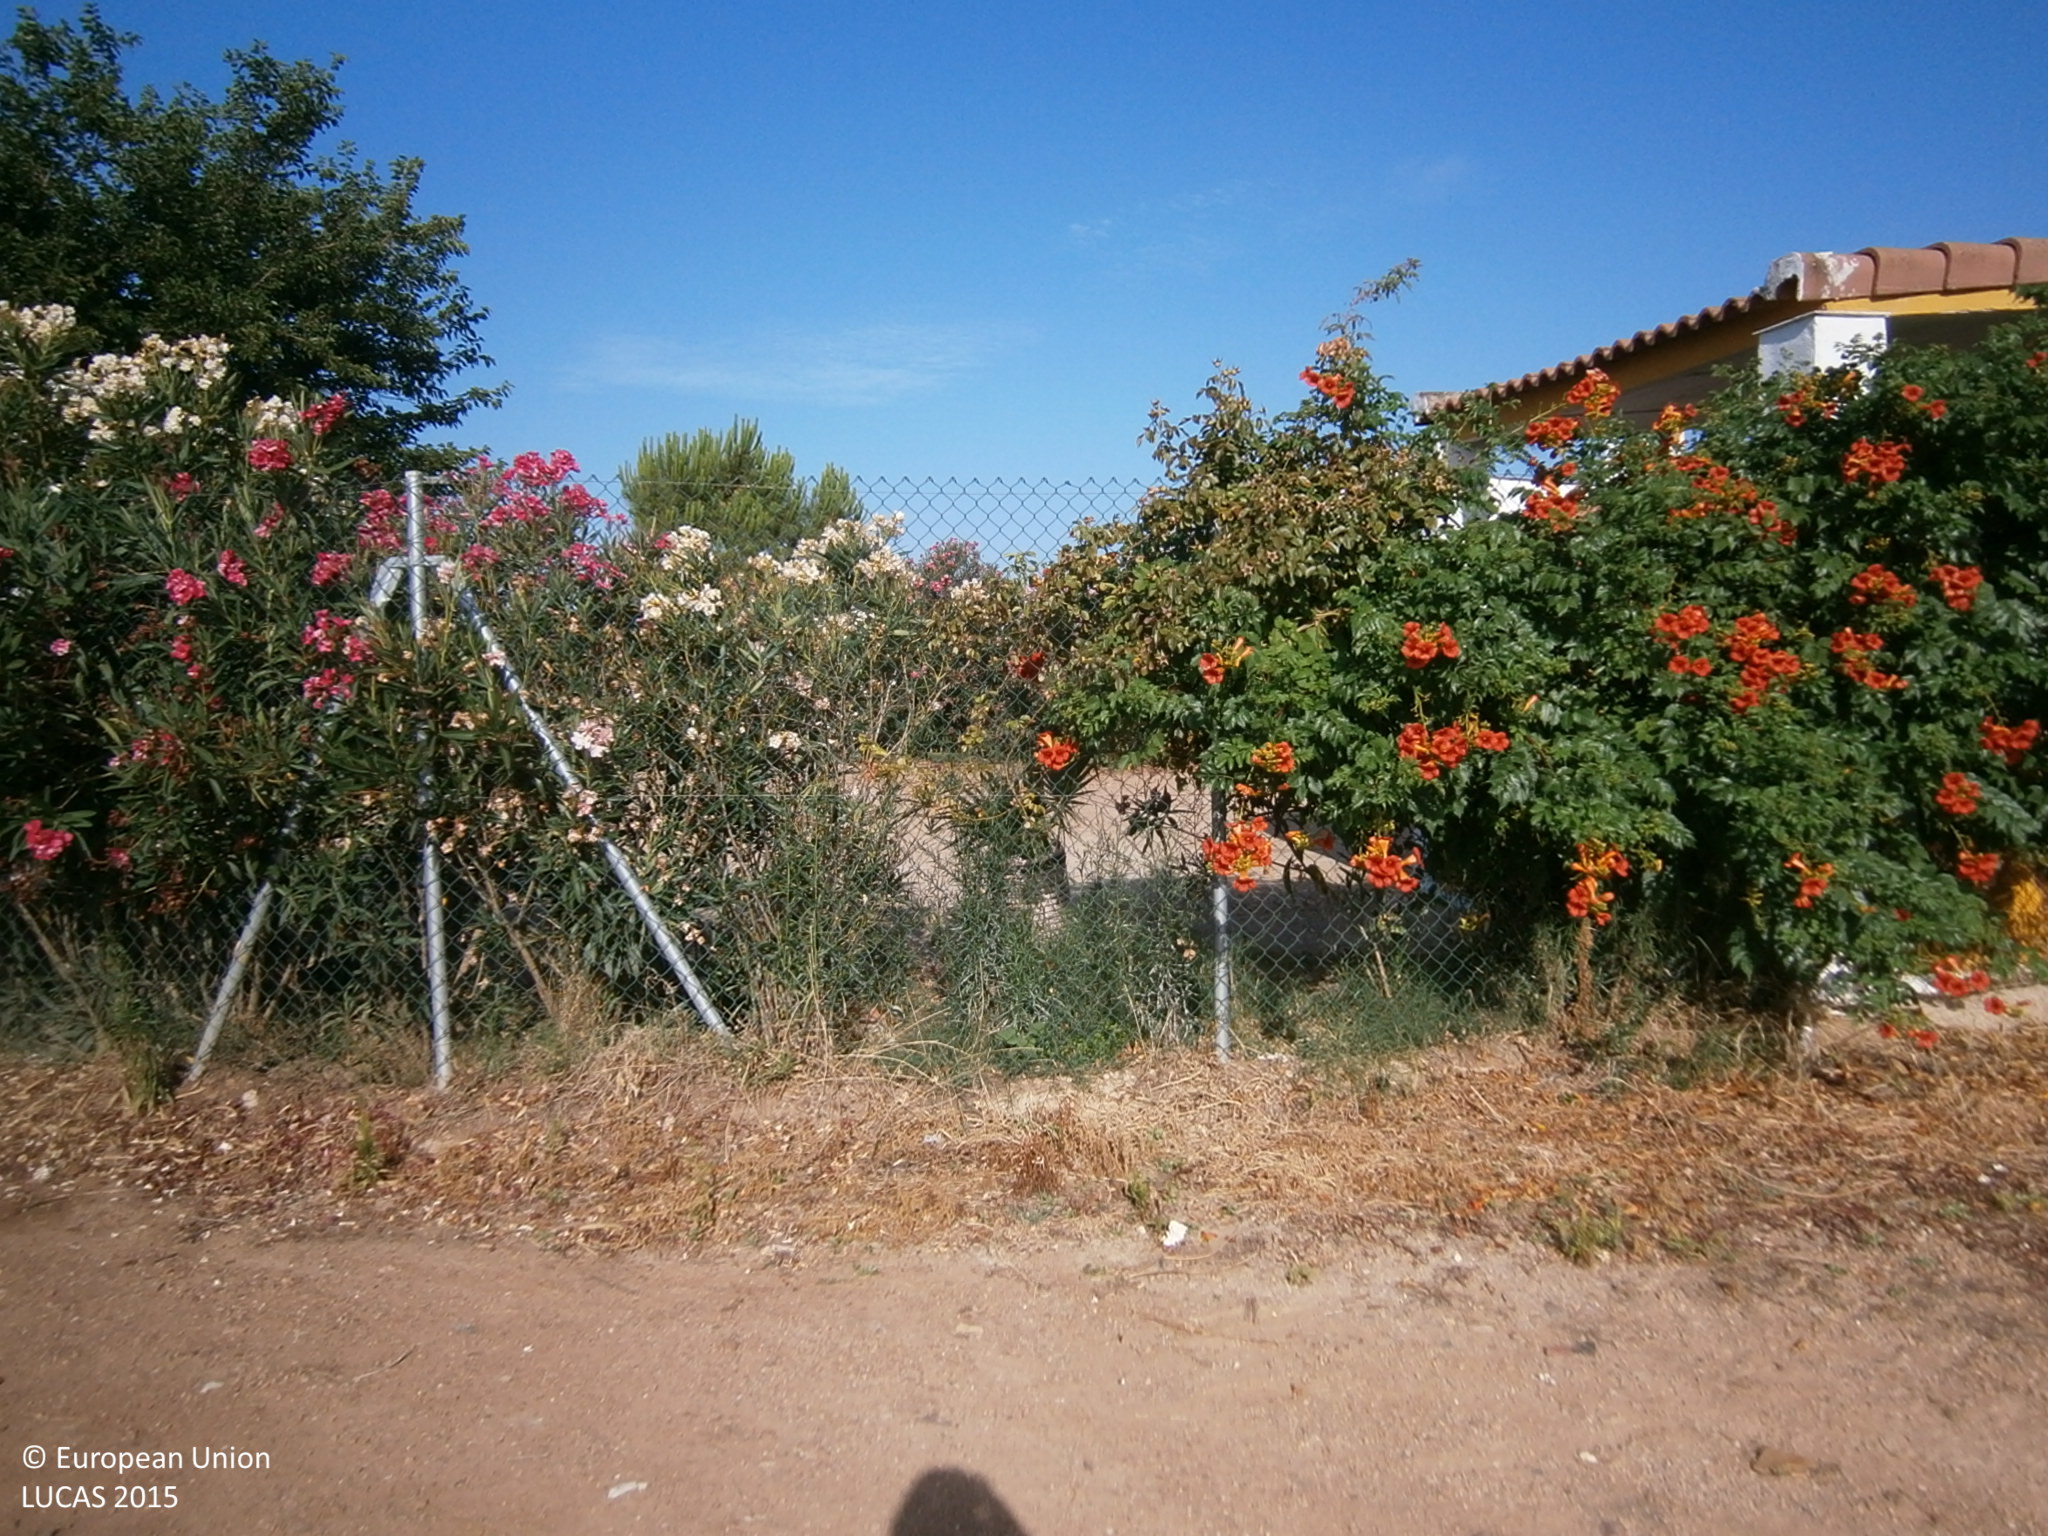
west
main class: Grassland
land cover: Grassland with sparse tree/shrub cover
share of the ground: > 75 %
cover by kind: herbaceous plants 90 %, broadleaved forest trees 5 %, unconsolidated bare surface 5 %
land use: Agriculture (excluding fallow land and kitchen gardens)
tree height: > 5 m
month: July
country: ES
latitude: 38.9900
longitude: -6.7026
